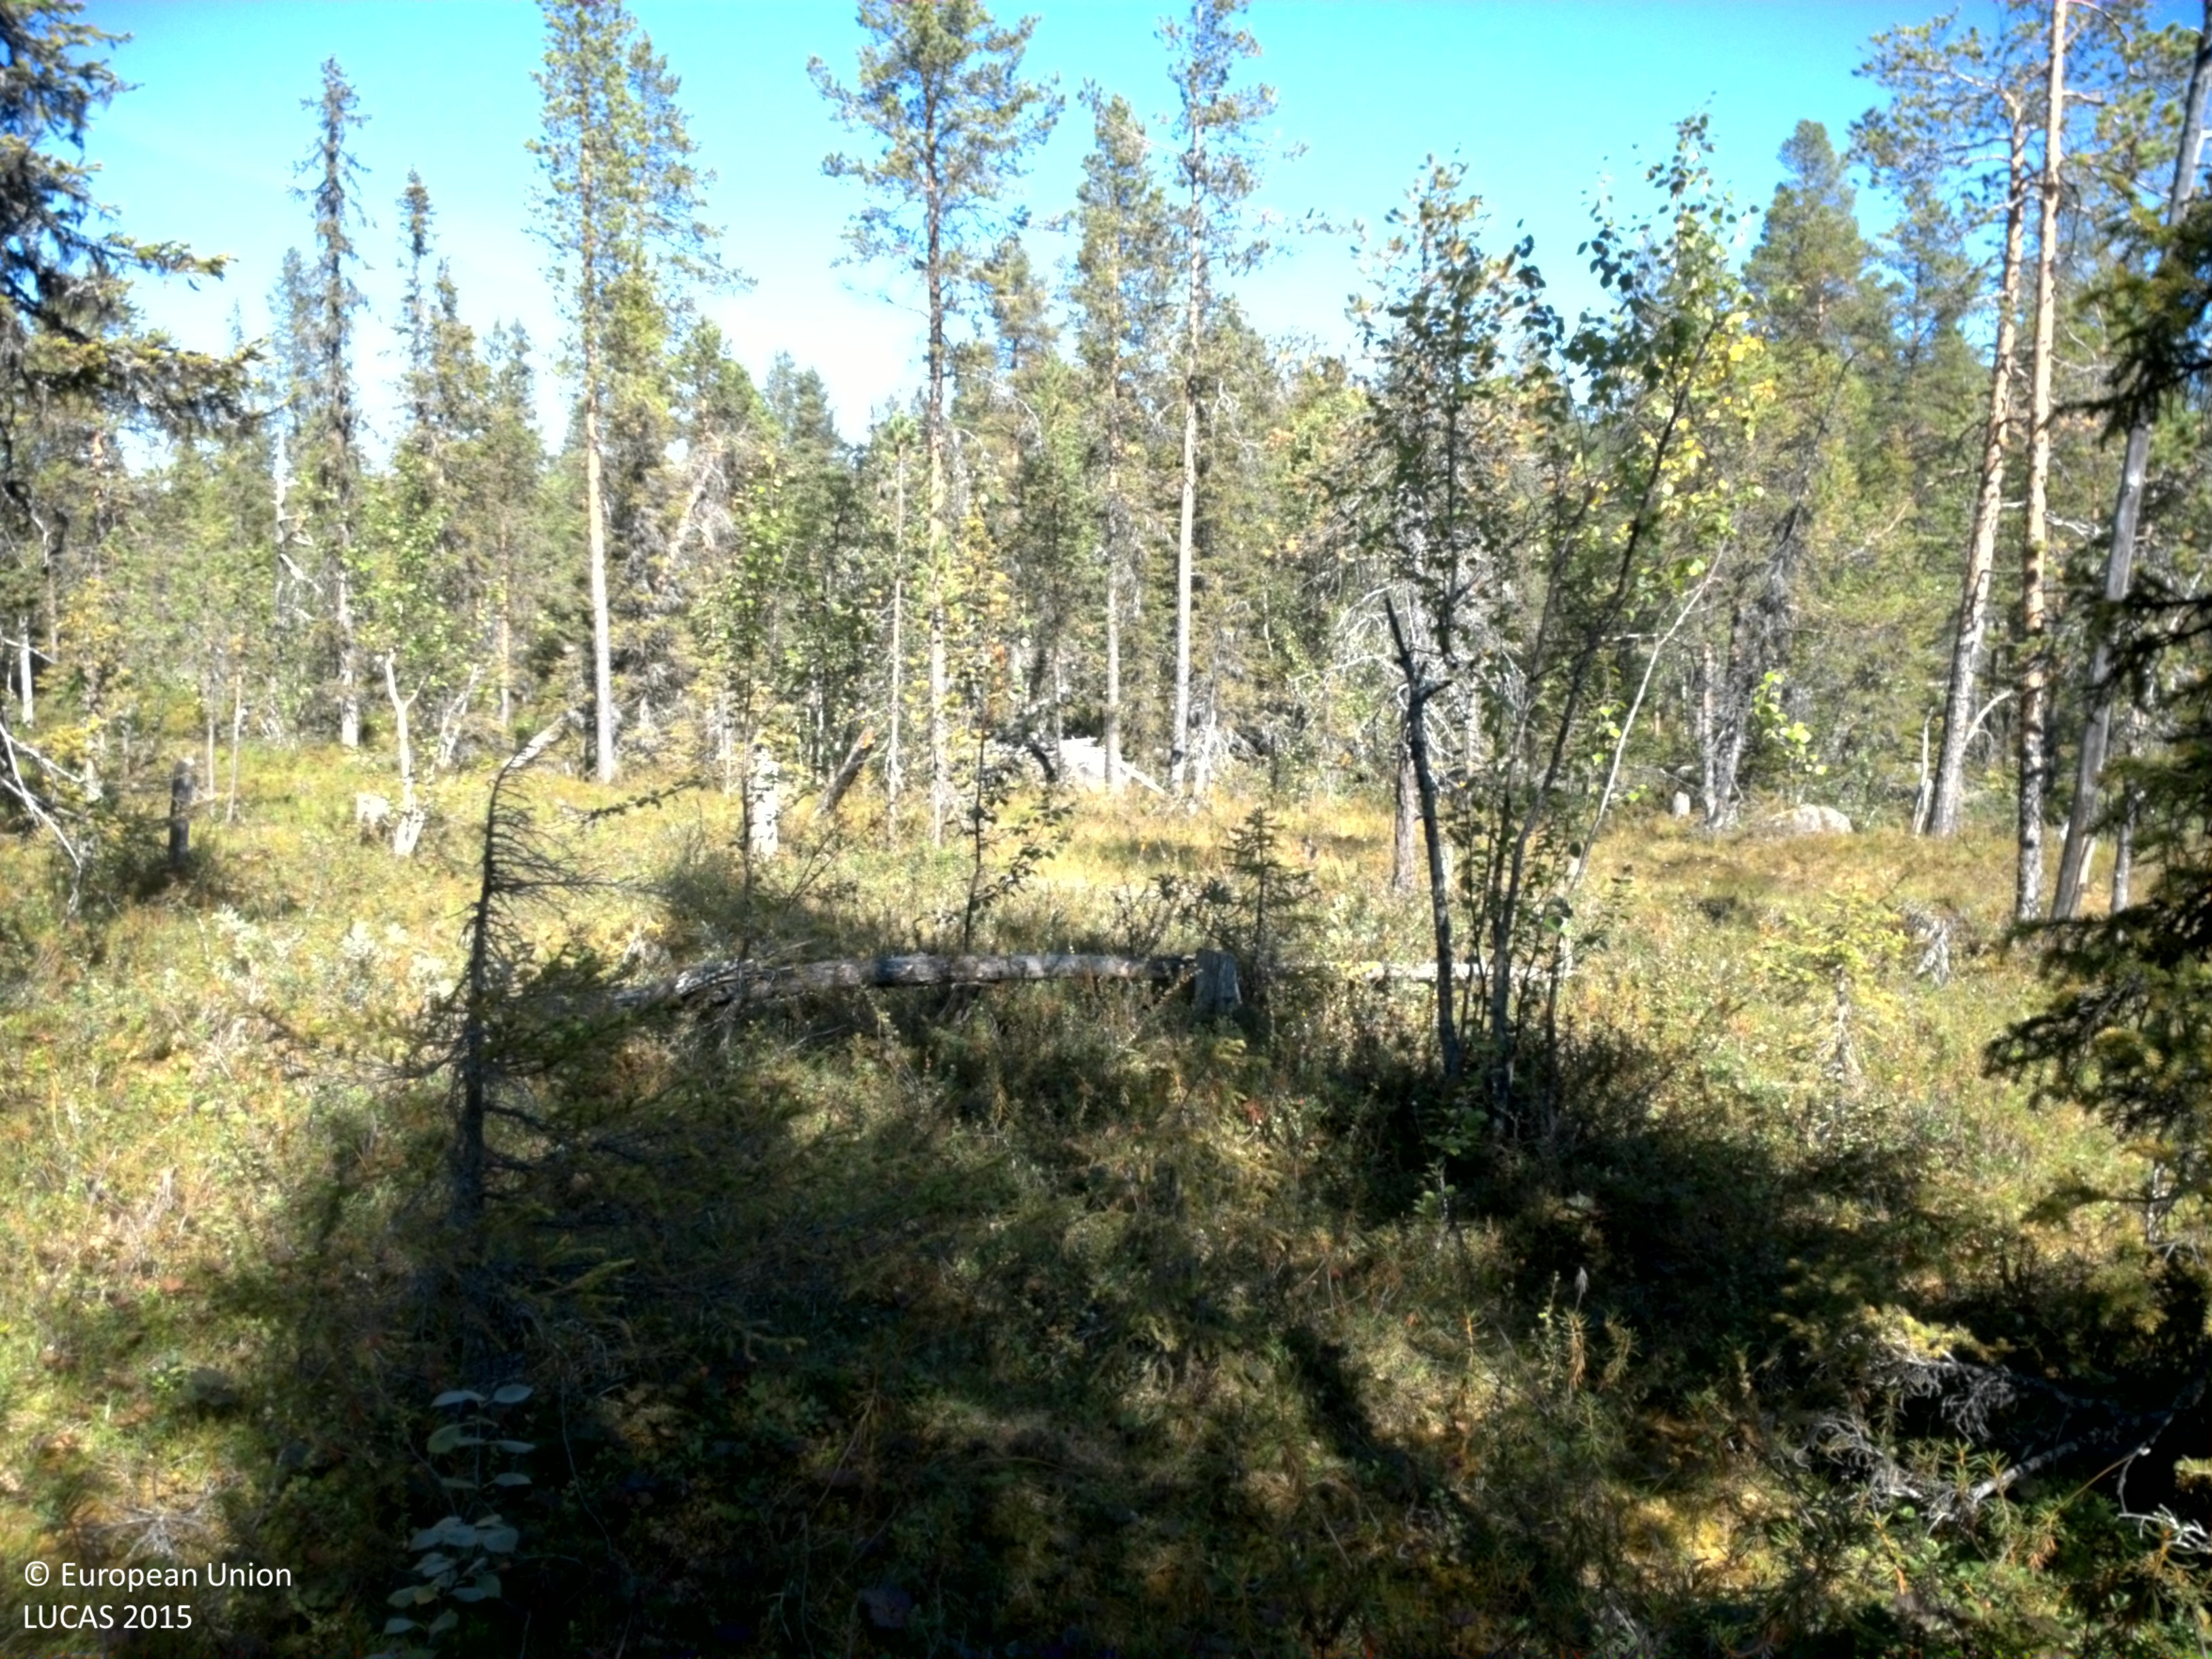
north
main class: Woodland
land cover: Pine dominated coniferous woodland
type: boreal forest
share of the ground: 25 - 50 %
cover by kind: shrubs 70 %, coniferous forest trees 25 %, broadleaved forest trees 5 %
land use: Forestry
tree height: > 5 m
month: August
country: SE
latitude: 66.6287
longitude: 18.8282
